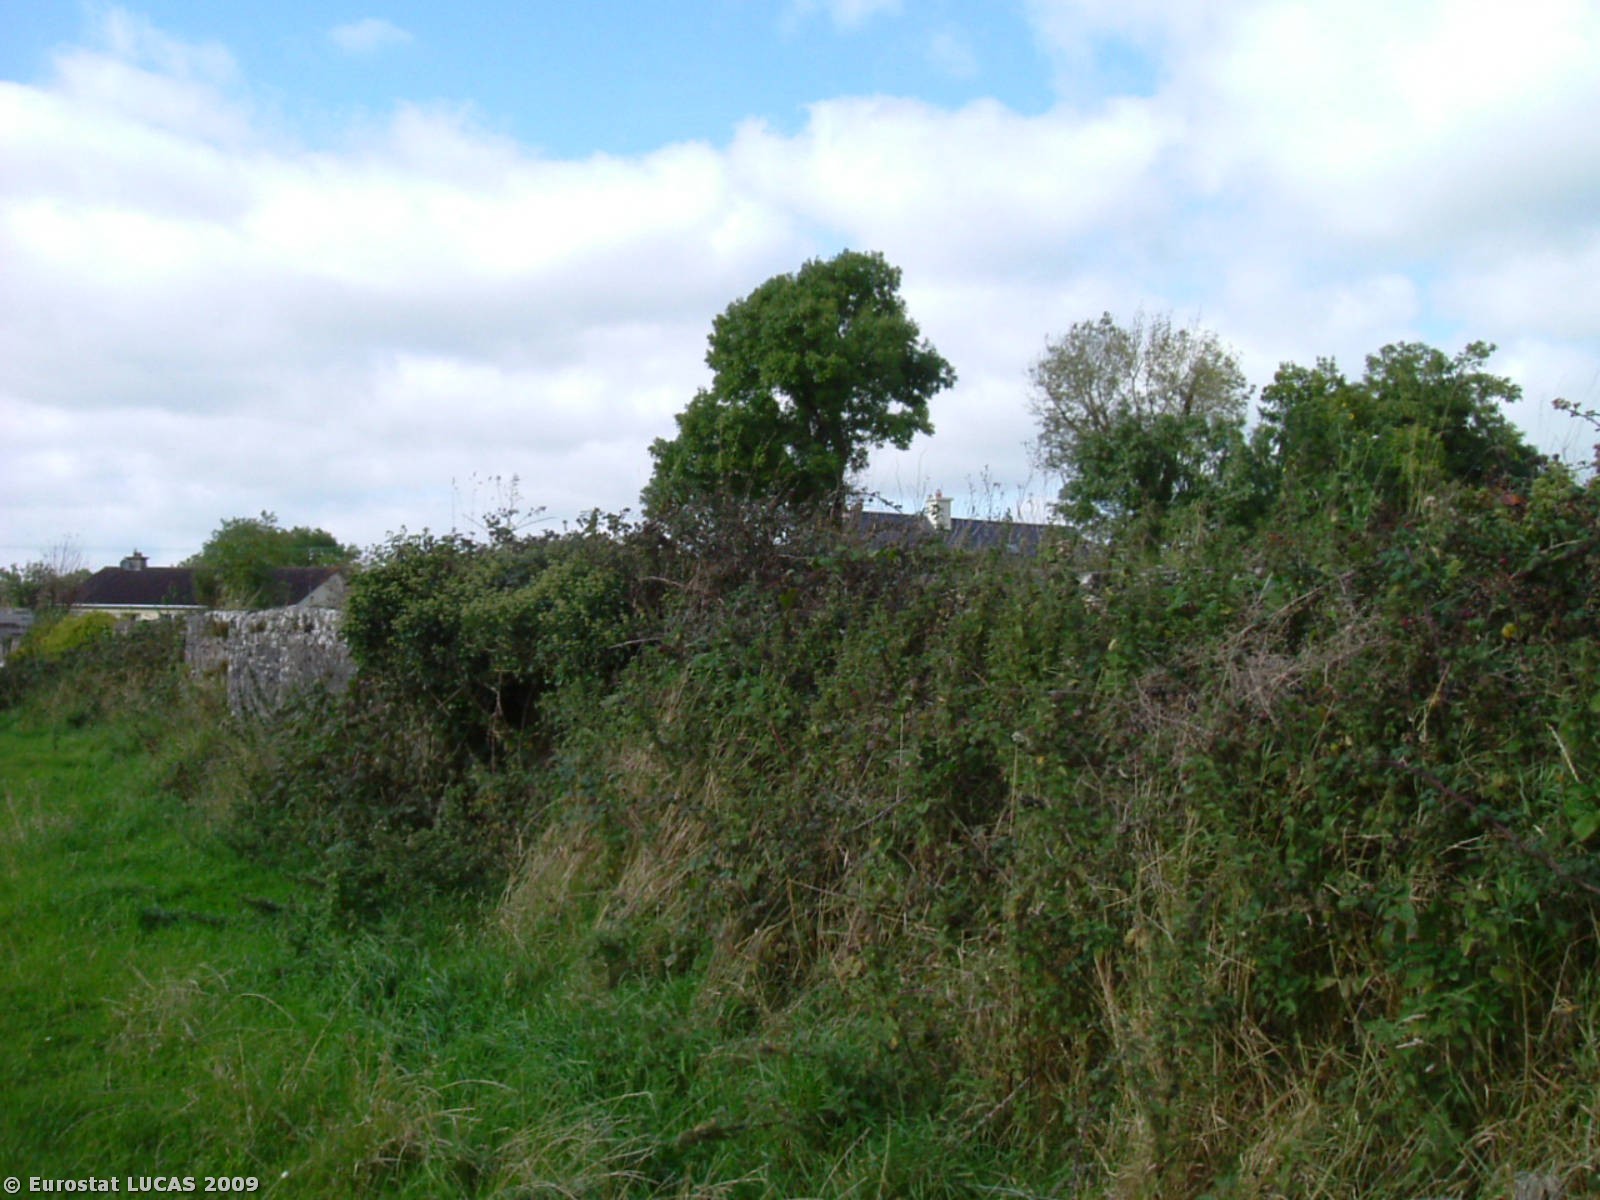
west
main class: Grassland
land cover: Grassland without tree/shrub cover
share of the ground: > 75 %
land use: Agriculture (excluding fallow land and kitchen gardens)
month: September
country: IE
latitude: 52.8038
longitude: -7.8060
